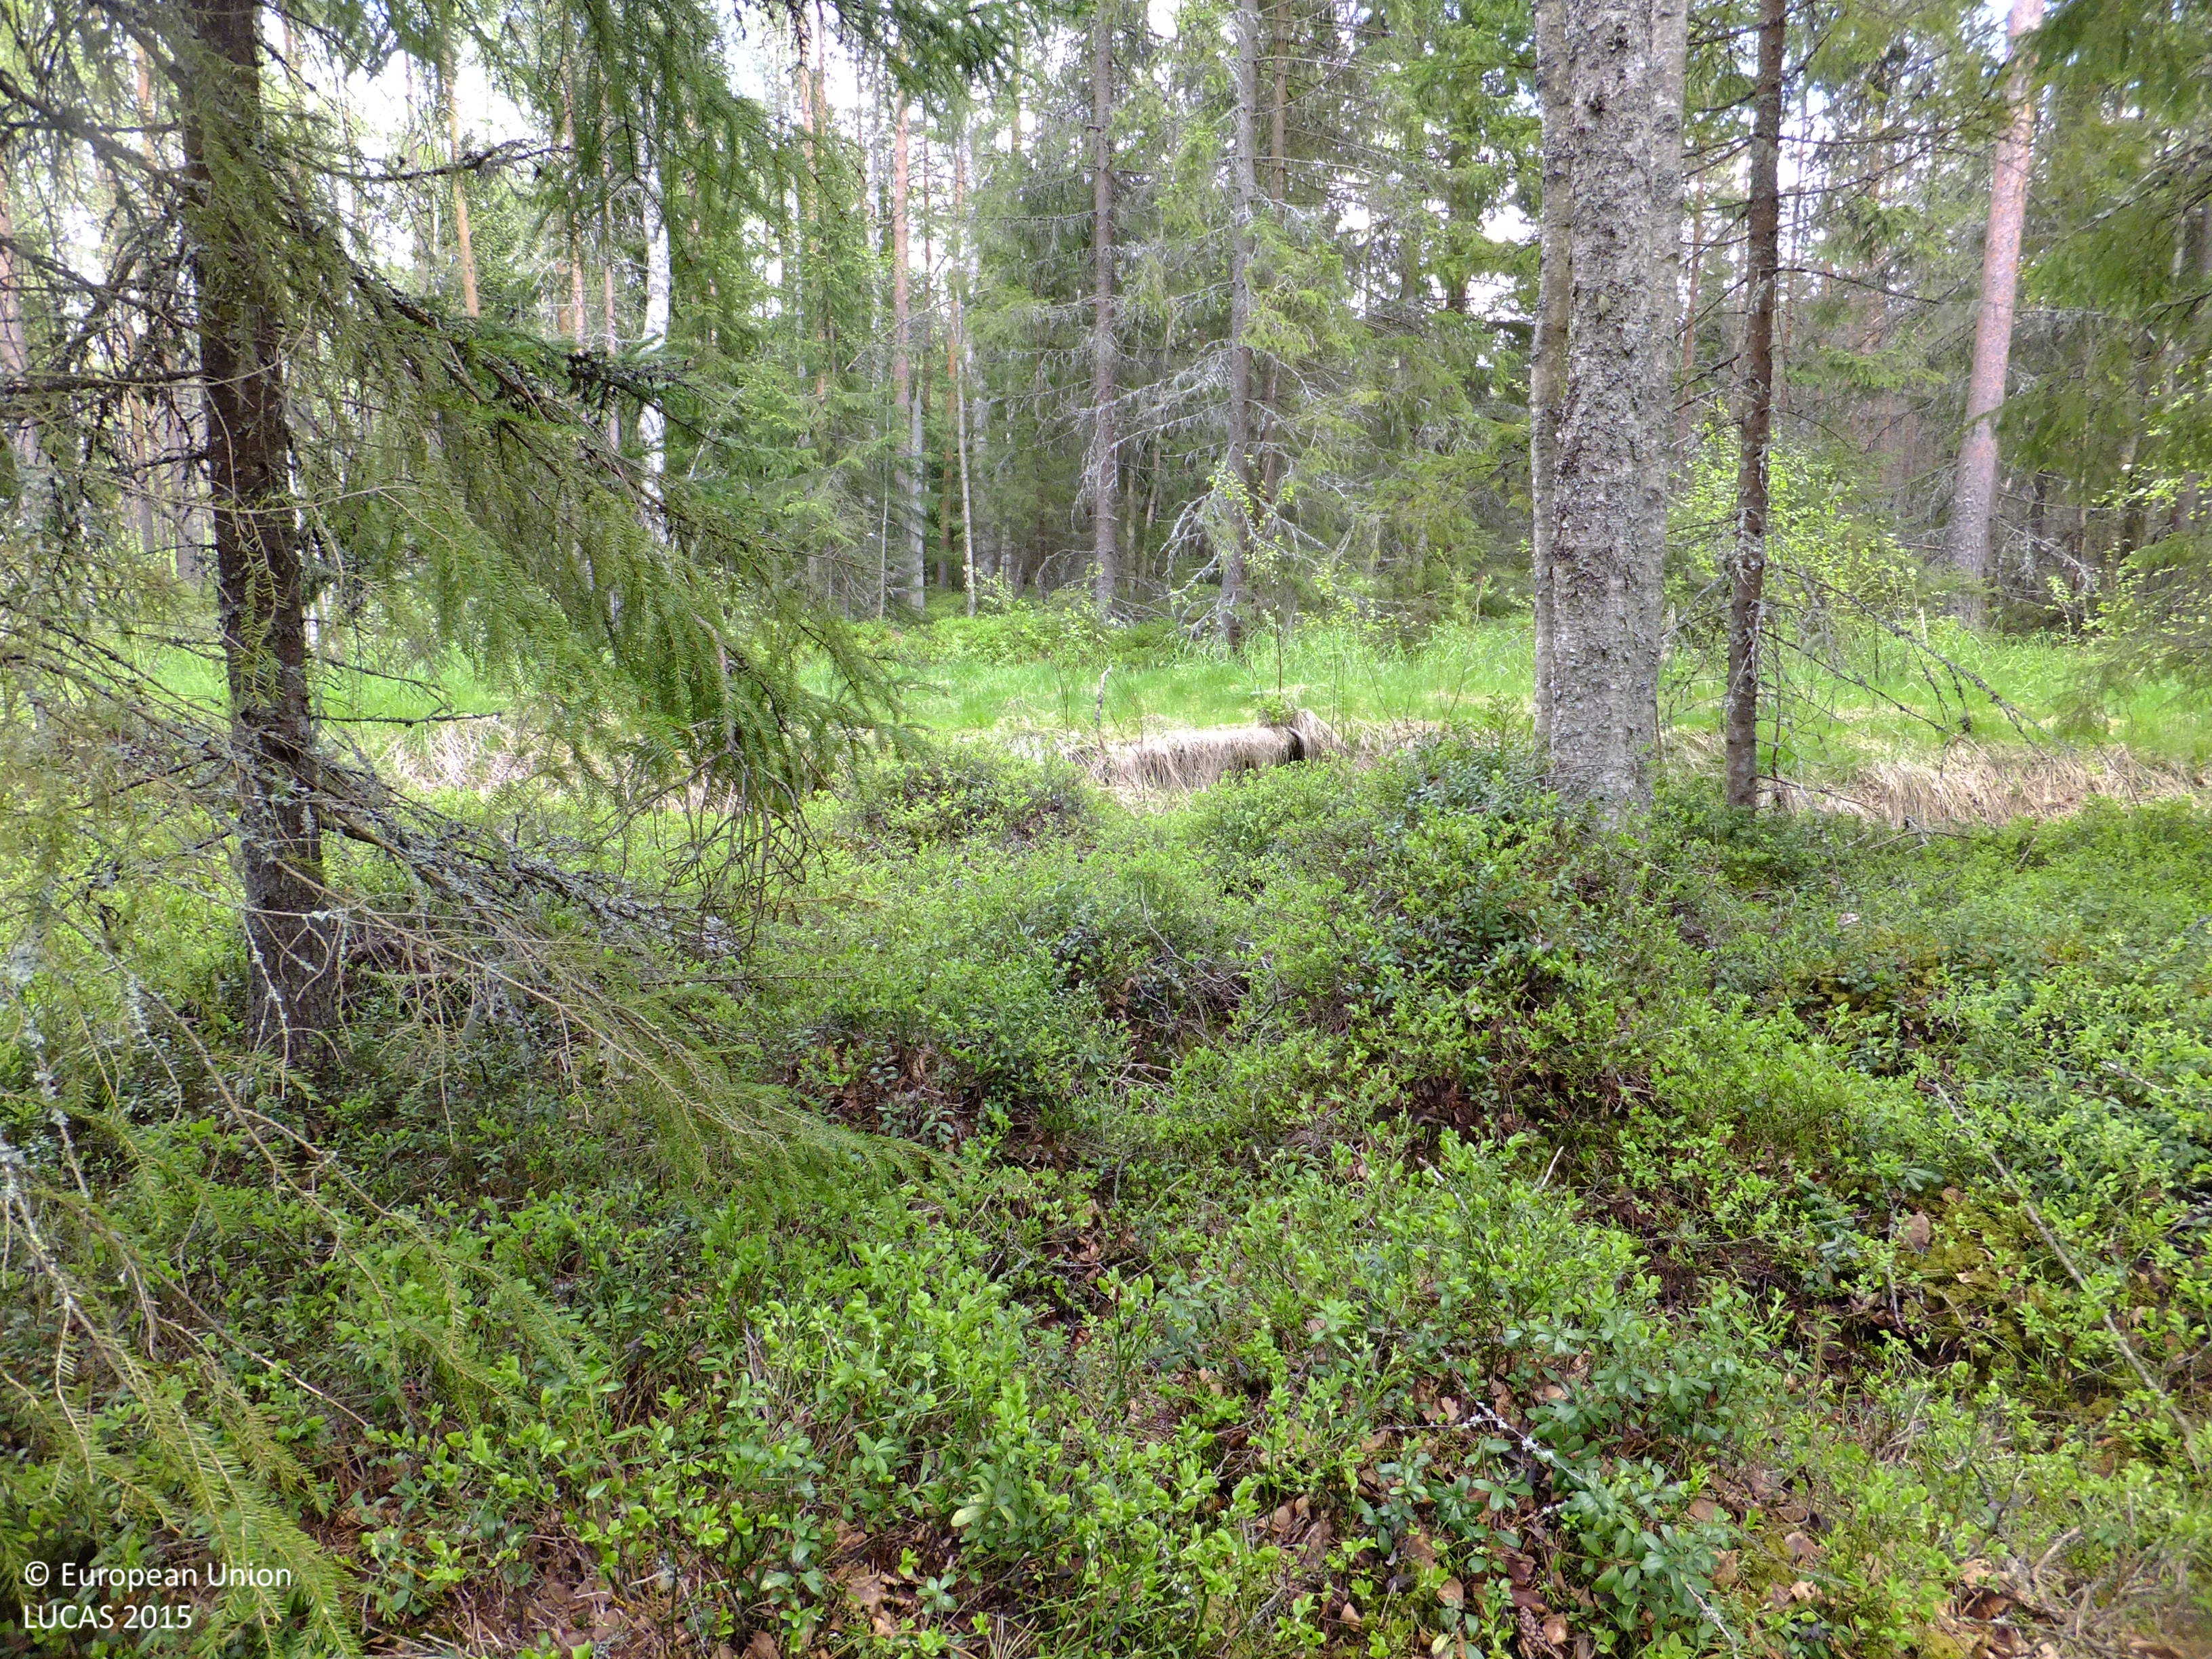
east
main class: Woodland
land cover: Spruce dominated mixed woodland
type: boreal forest
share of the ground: > 75 %
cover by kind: coniferous forest trees 50 %, broadleaved forest trees 30 %, shrubs 20 %
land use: Forestry
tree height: > 5 m
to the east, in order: Spruce dominated mixed woodland; Ditches and canals; Spontaneously vegetated surfaces; Ditches and canals; Spruce dominated coniferous woodland; Pine dominated coniferous woodland; Ditches and canals; Pine dominated coniferous woodland; Spontaneously vegetated surfaces; Pine dominated coniferous woodland
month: May
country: FI
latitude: 63.6112
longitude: 22.6930
